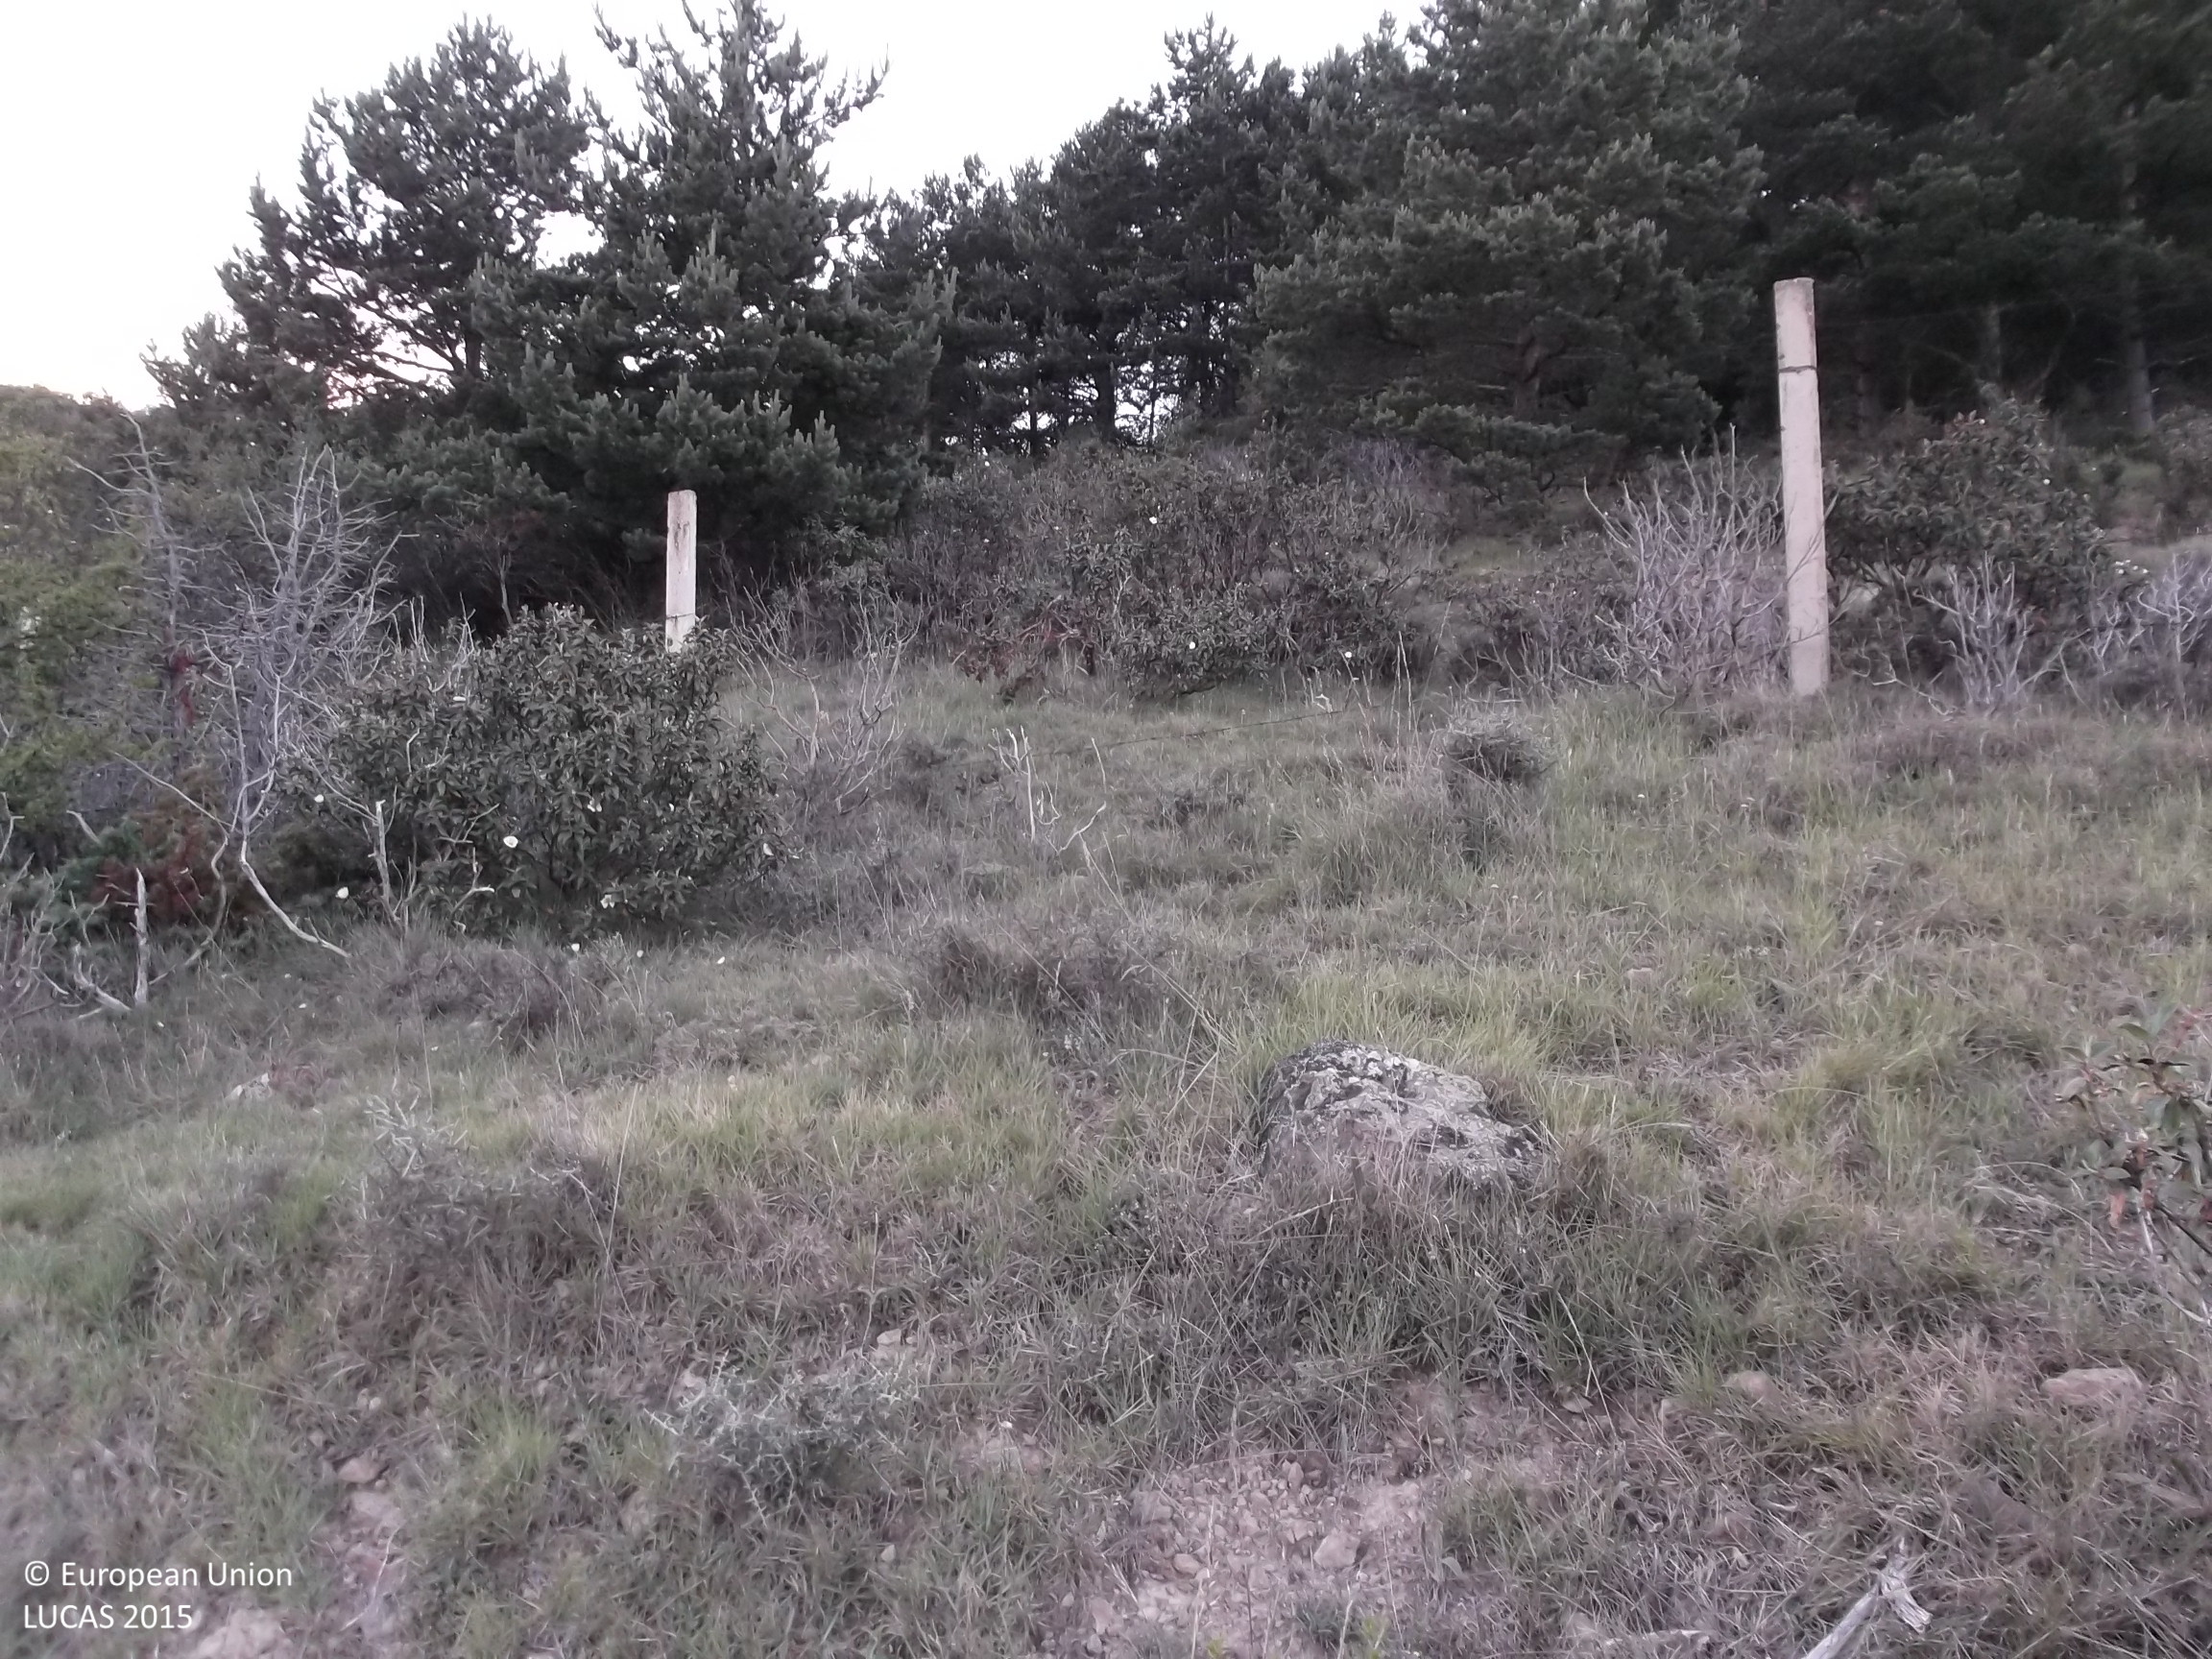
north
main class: Shrubland
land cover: Shrubland with sparse tree cover
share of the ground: 50 - 75 %
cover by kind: shrubs 60 %, herbaceous plants 20 %, unconsolidated bare surface 15 %, broadleaved forest trees 5 %
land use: Semi-natural and natural areas not in use
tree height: < 5 m
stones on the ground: > 50 %
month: June
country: ES
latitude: 42.1360
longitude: -2.3201
